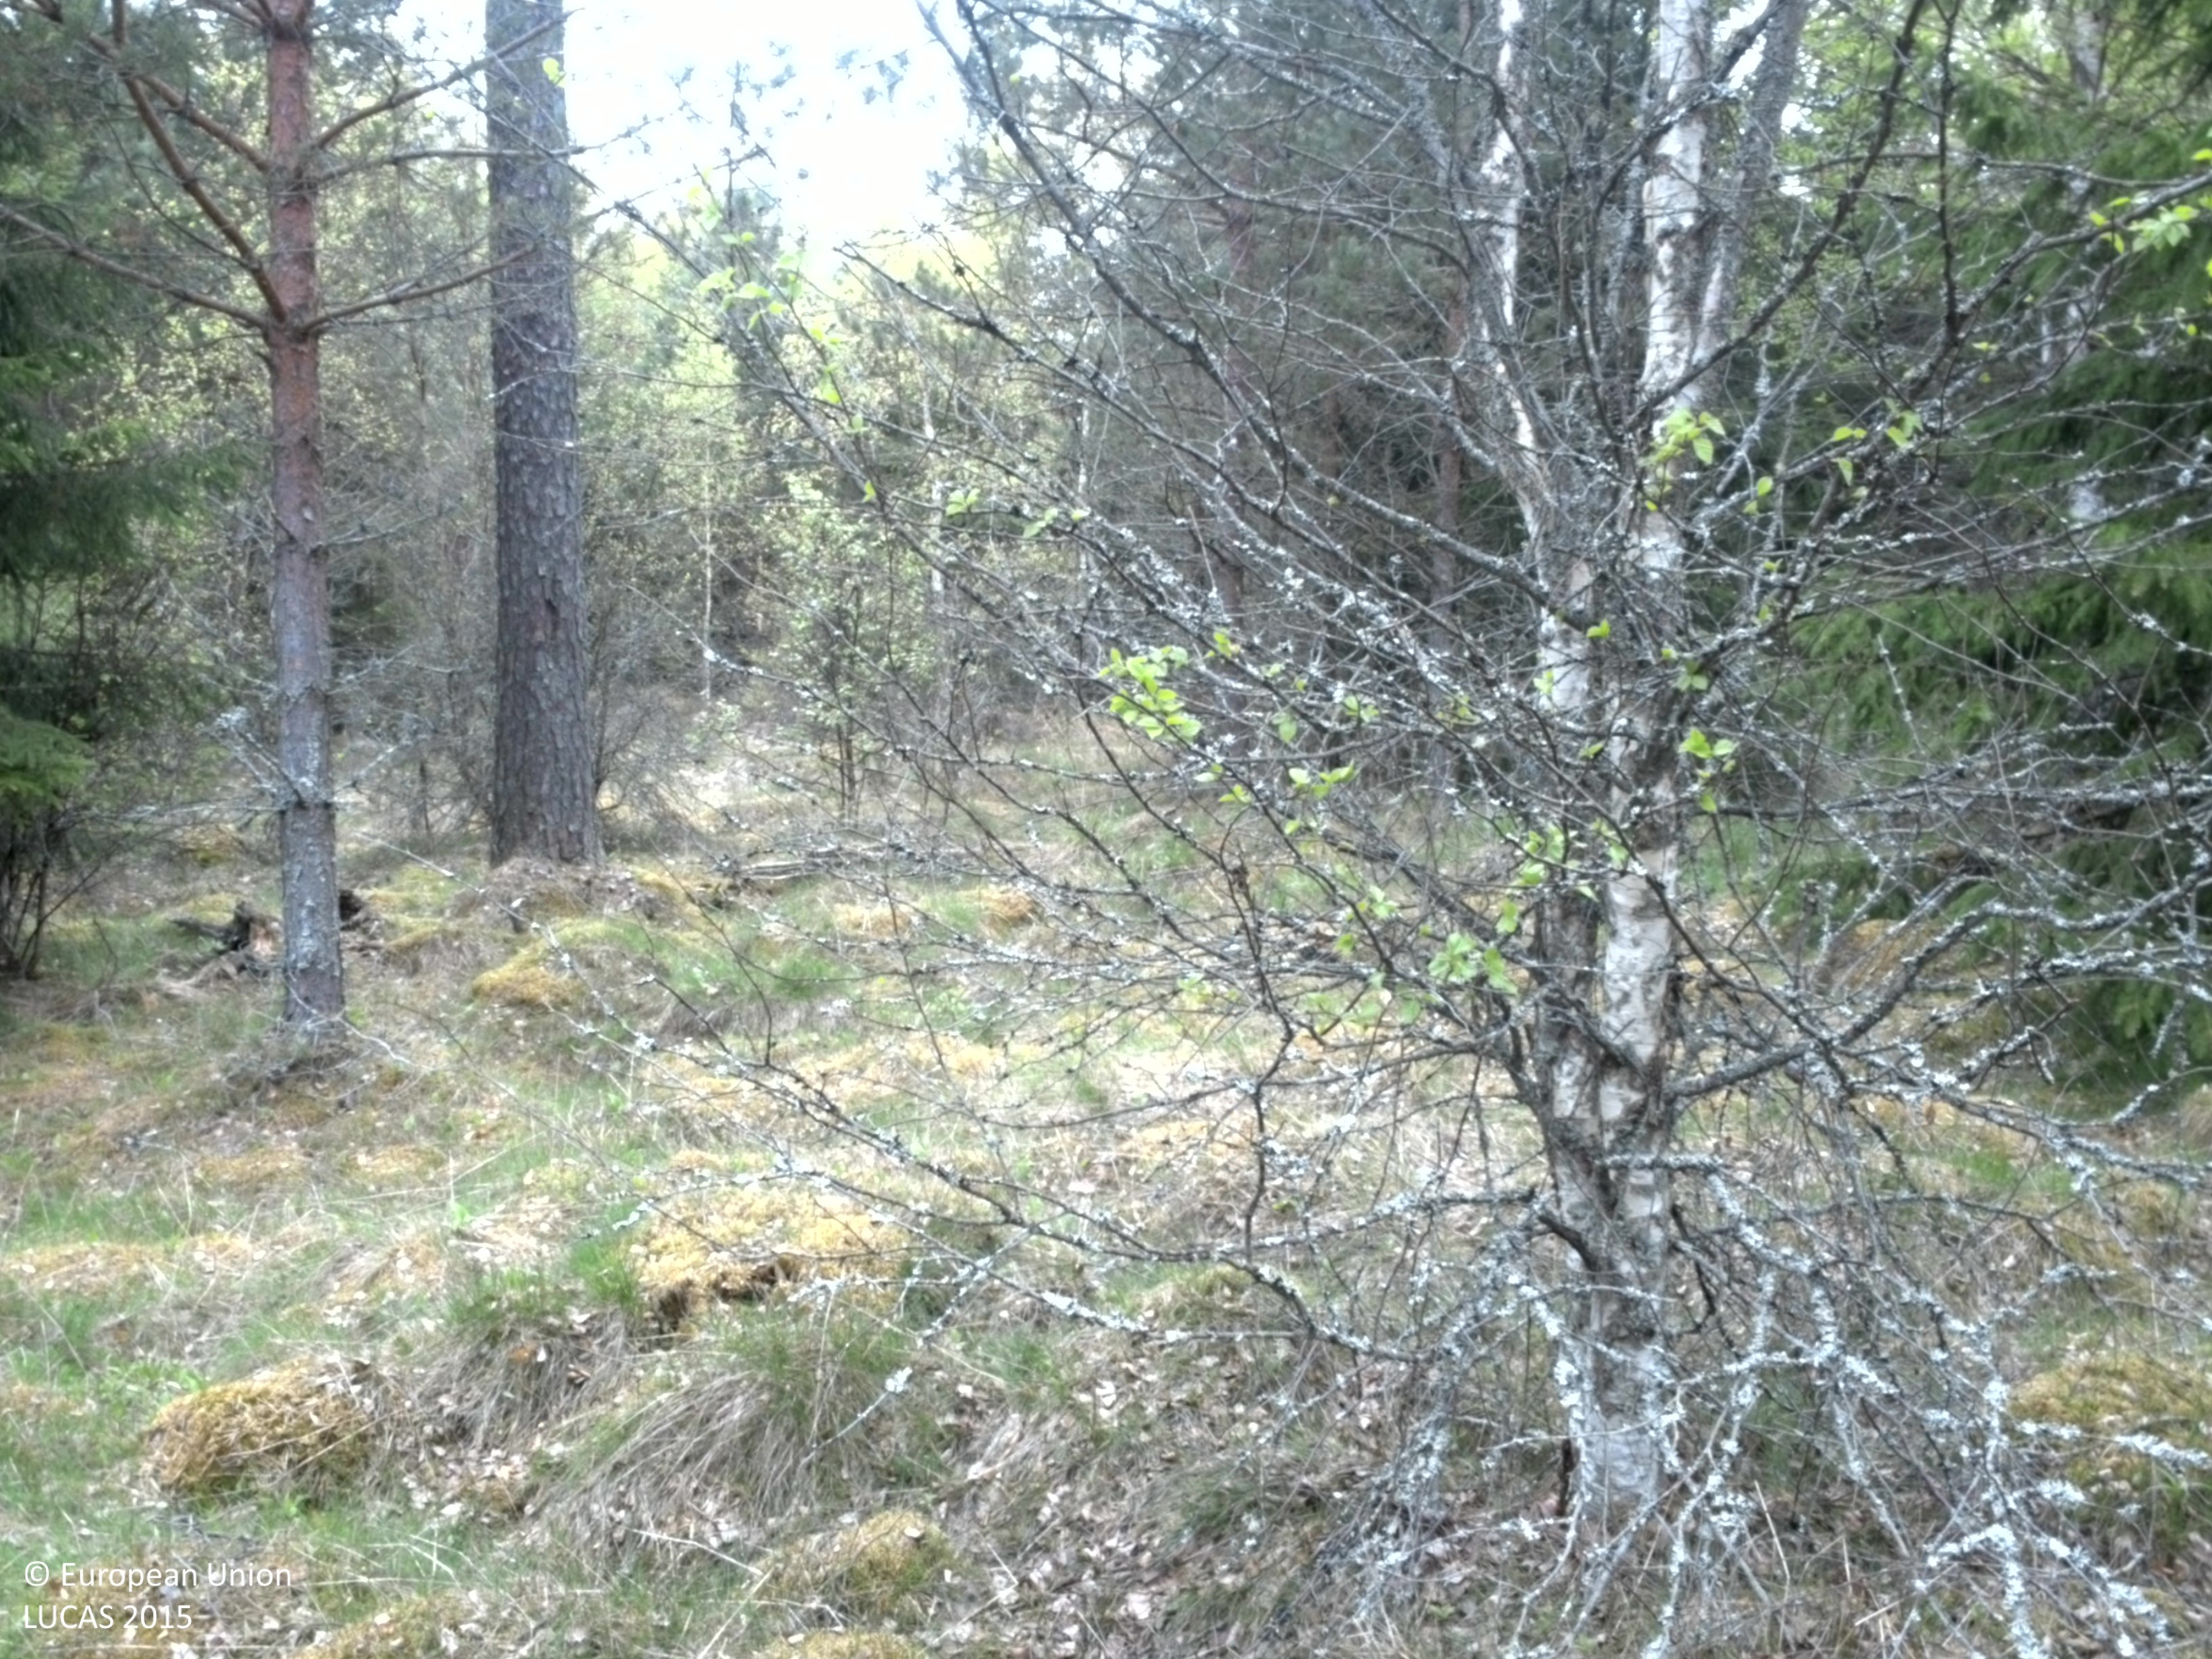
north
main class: Woodland
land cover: Pine dominated mixed woodland
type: boreal forest
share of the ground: > 75 %
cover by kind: coniferous forest trees 60 %, broadleaved forest trees 20 %, shrubs 10 %, herbaceous plants 10 %
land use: Forestry
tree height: > 5 m
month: May
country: SE
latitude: 59.2566
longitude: 14.0782
